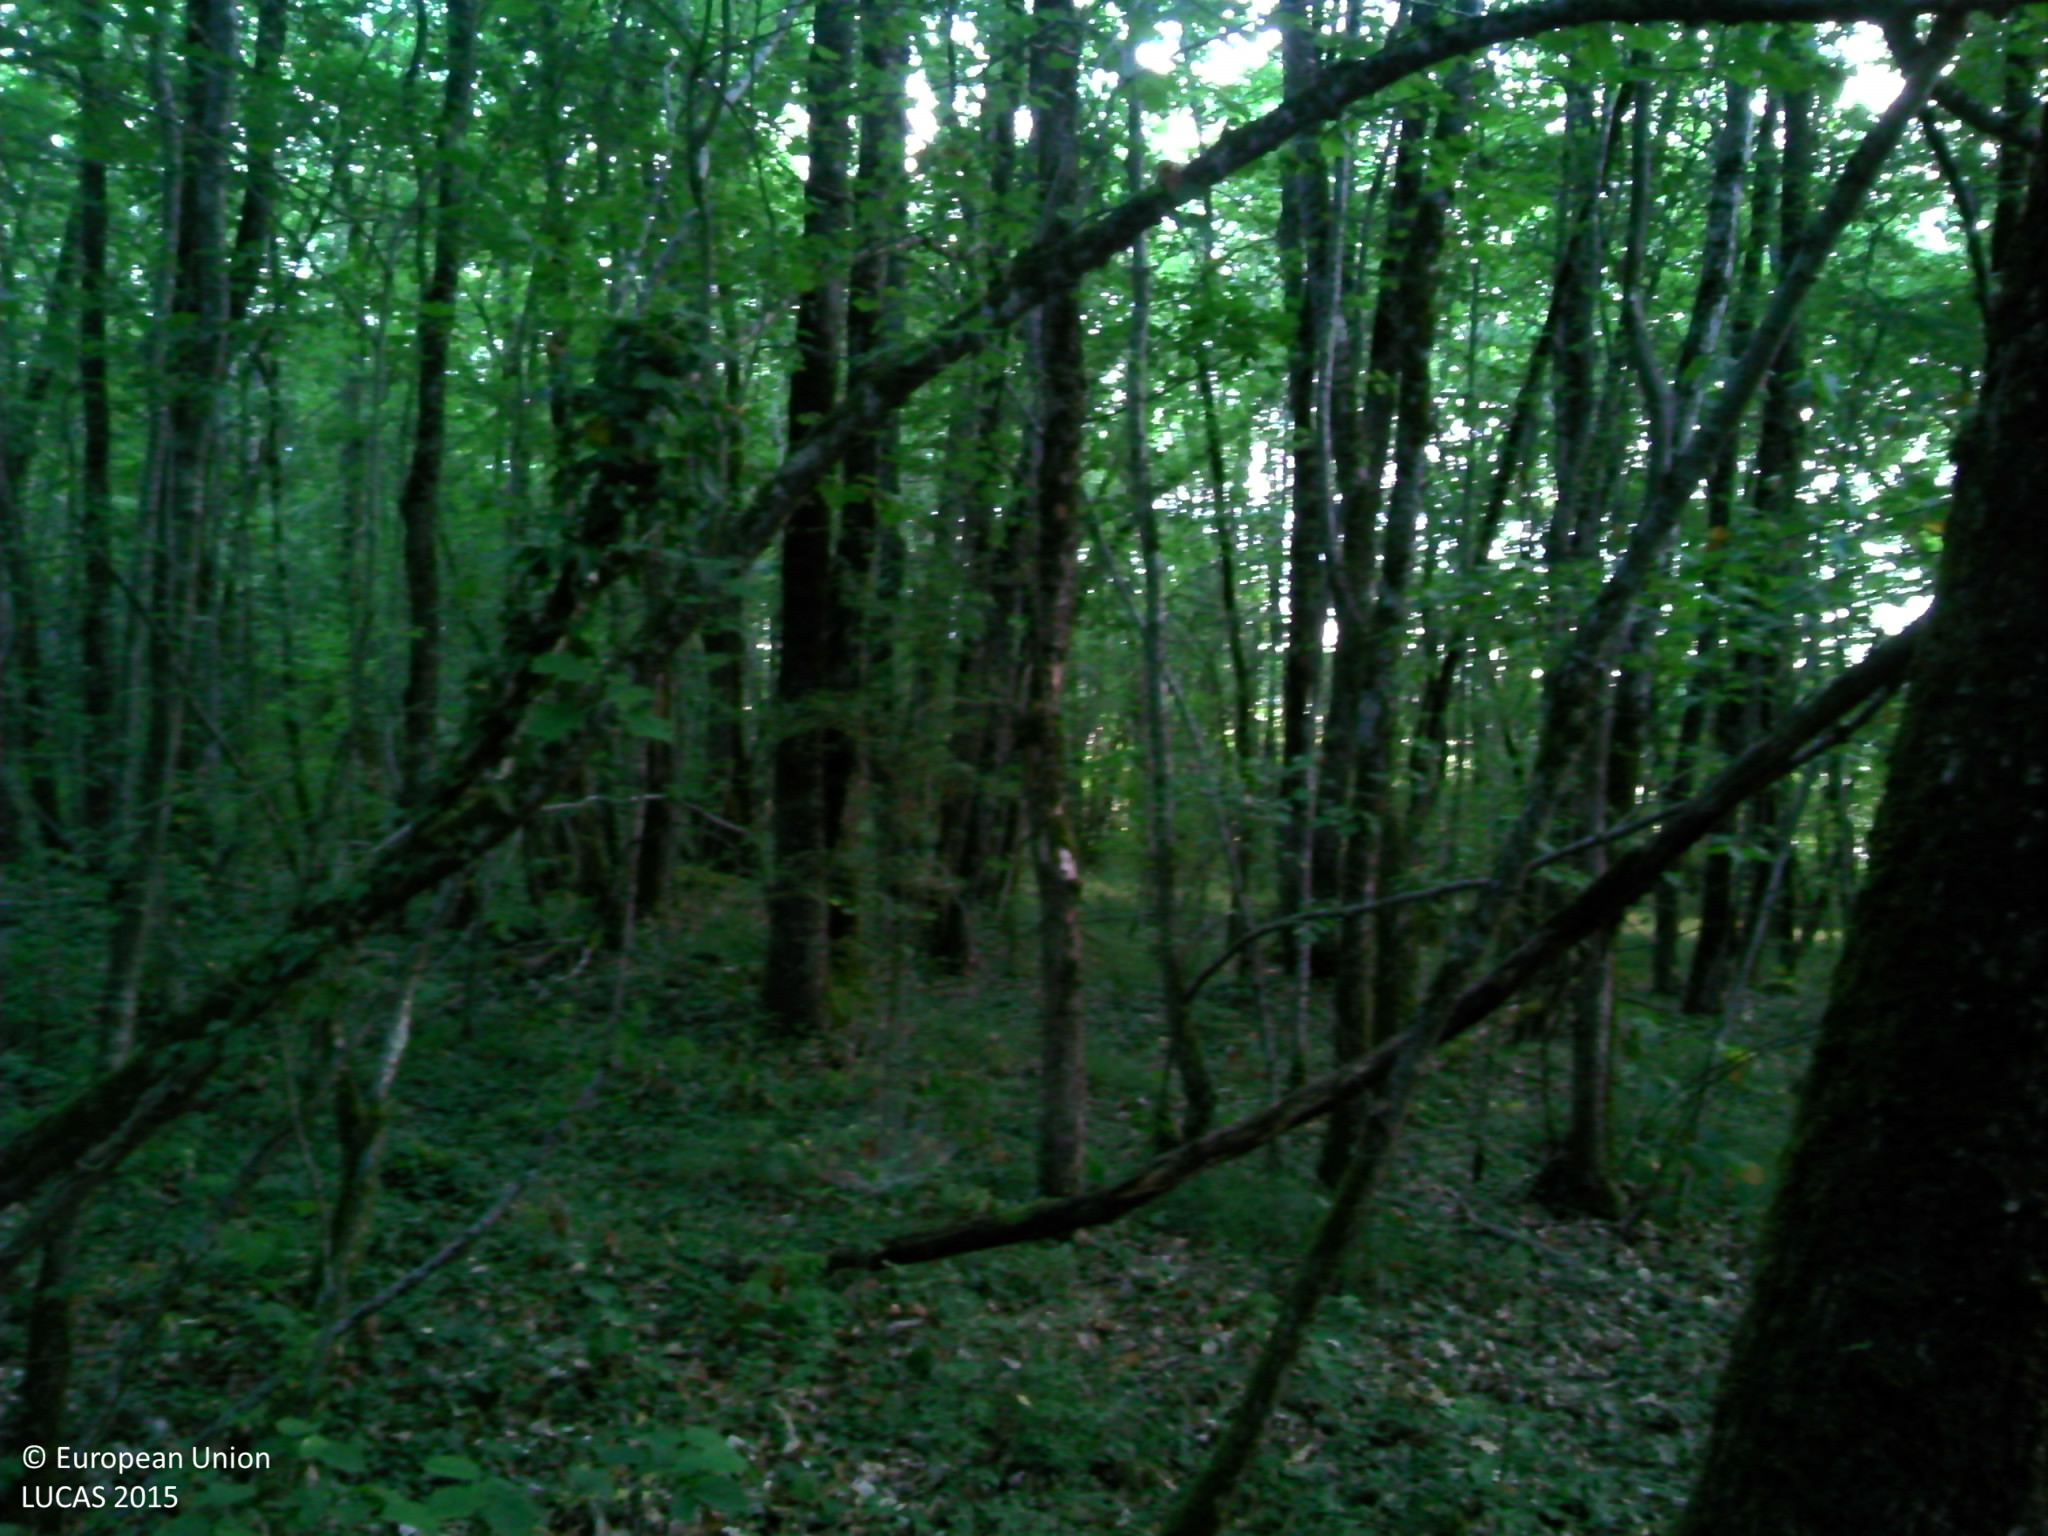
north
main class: Woodland
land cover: Broadleaved woodland
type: thermophilous deciduous forest
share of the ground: > 75 %
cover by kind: broadleaved forest trees 90 %, herbaceous plants 10 %
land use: Forestry
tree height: > 5 m
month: July
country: FR
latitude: 44.3270
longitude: 0.6519
